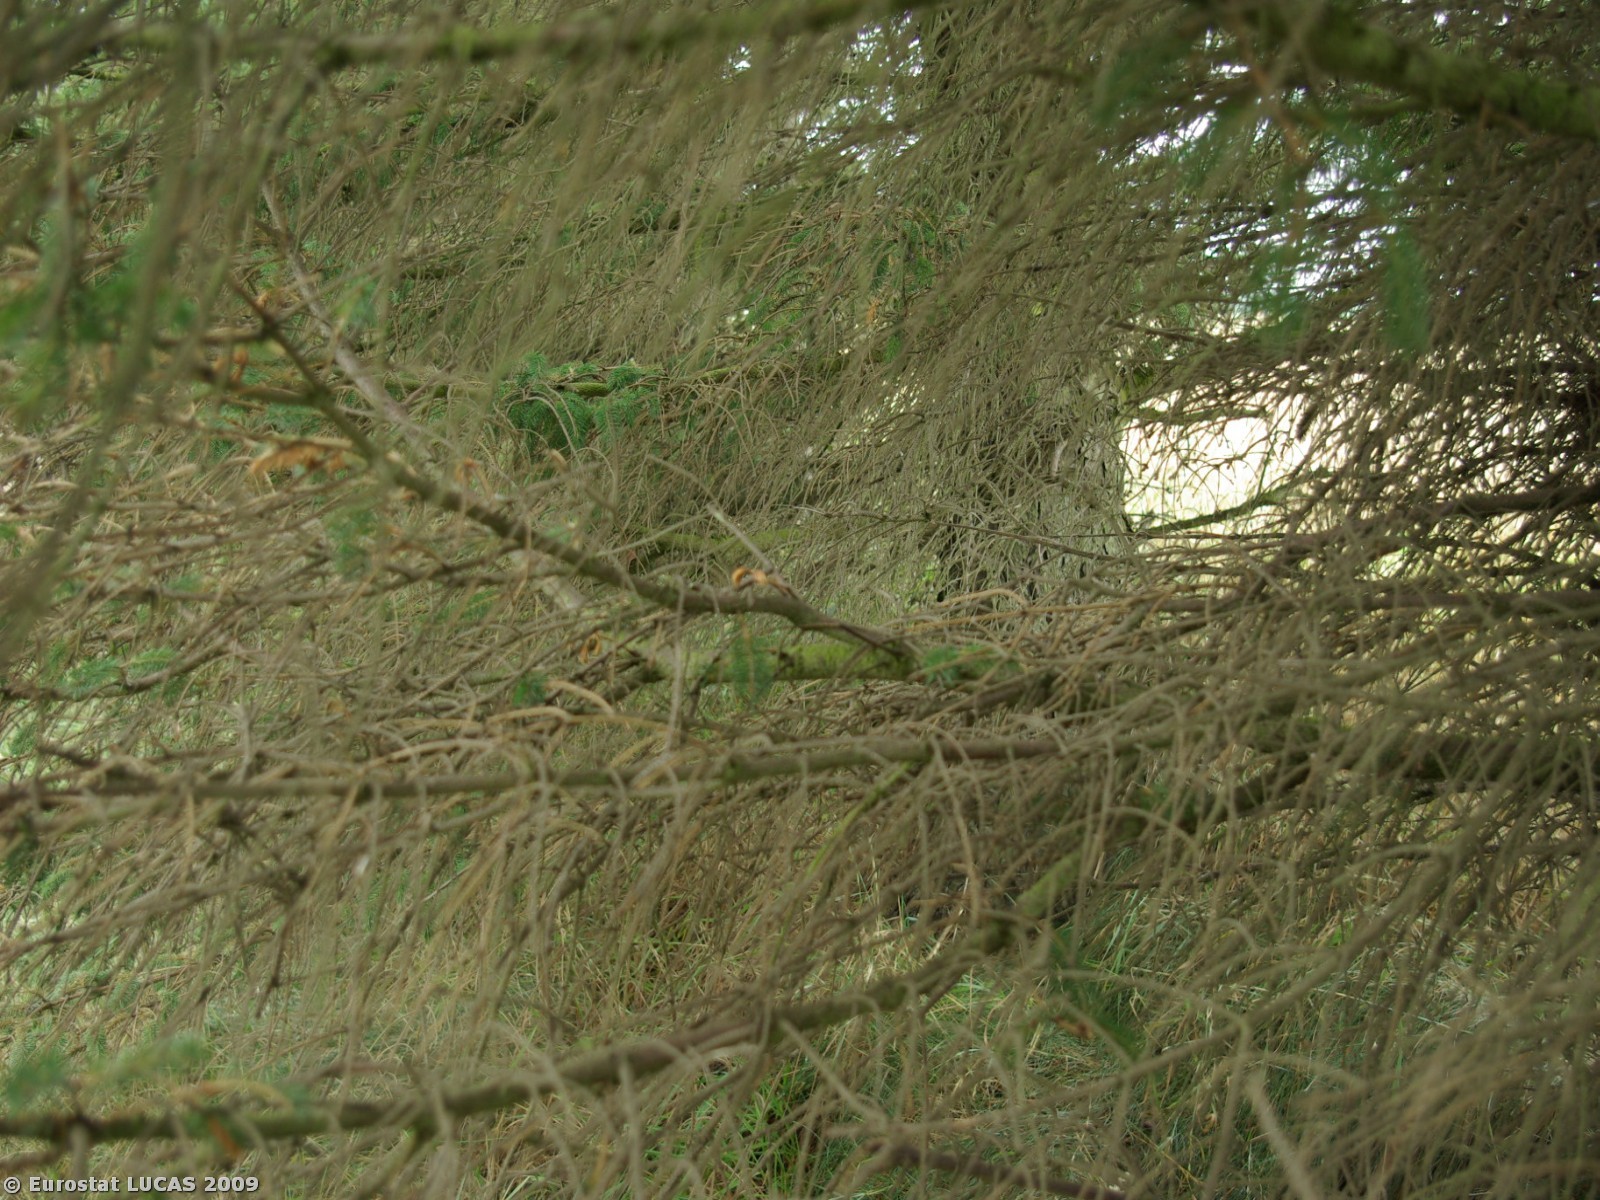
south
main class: Woodland
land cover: Coniferous woodland
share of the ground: 25 - 50 %
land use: Unused
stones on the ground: < 10 %
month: July
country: DK
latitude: 55.1218
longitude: 8.8249
